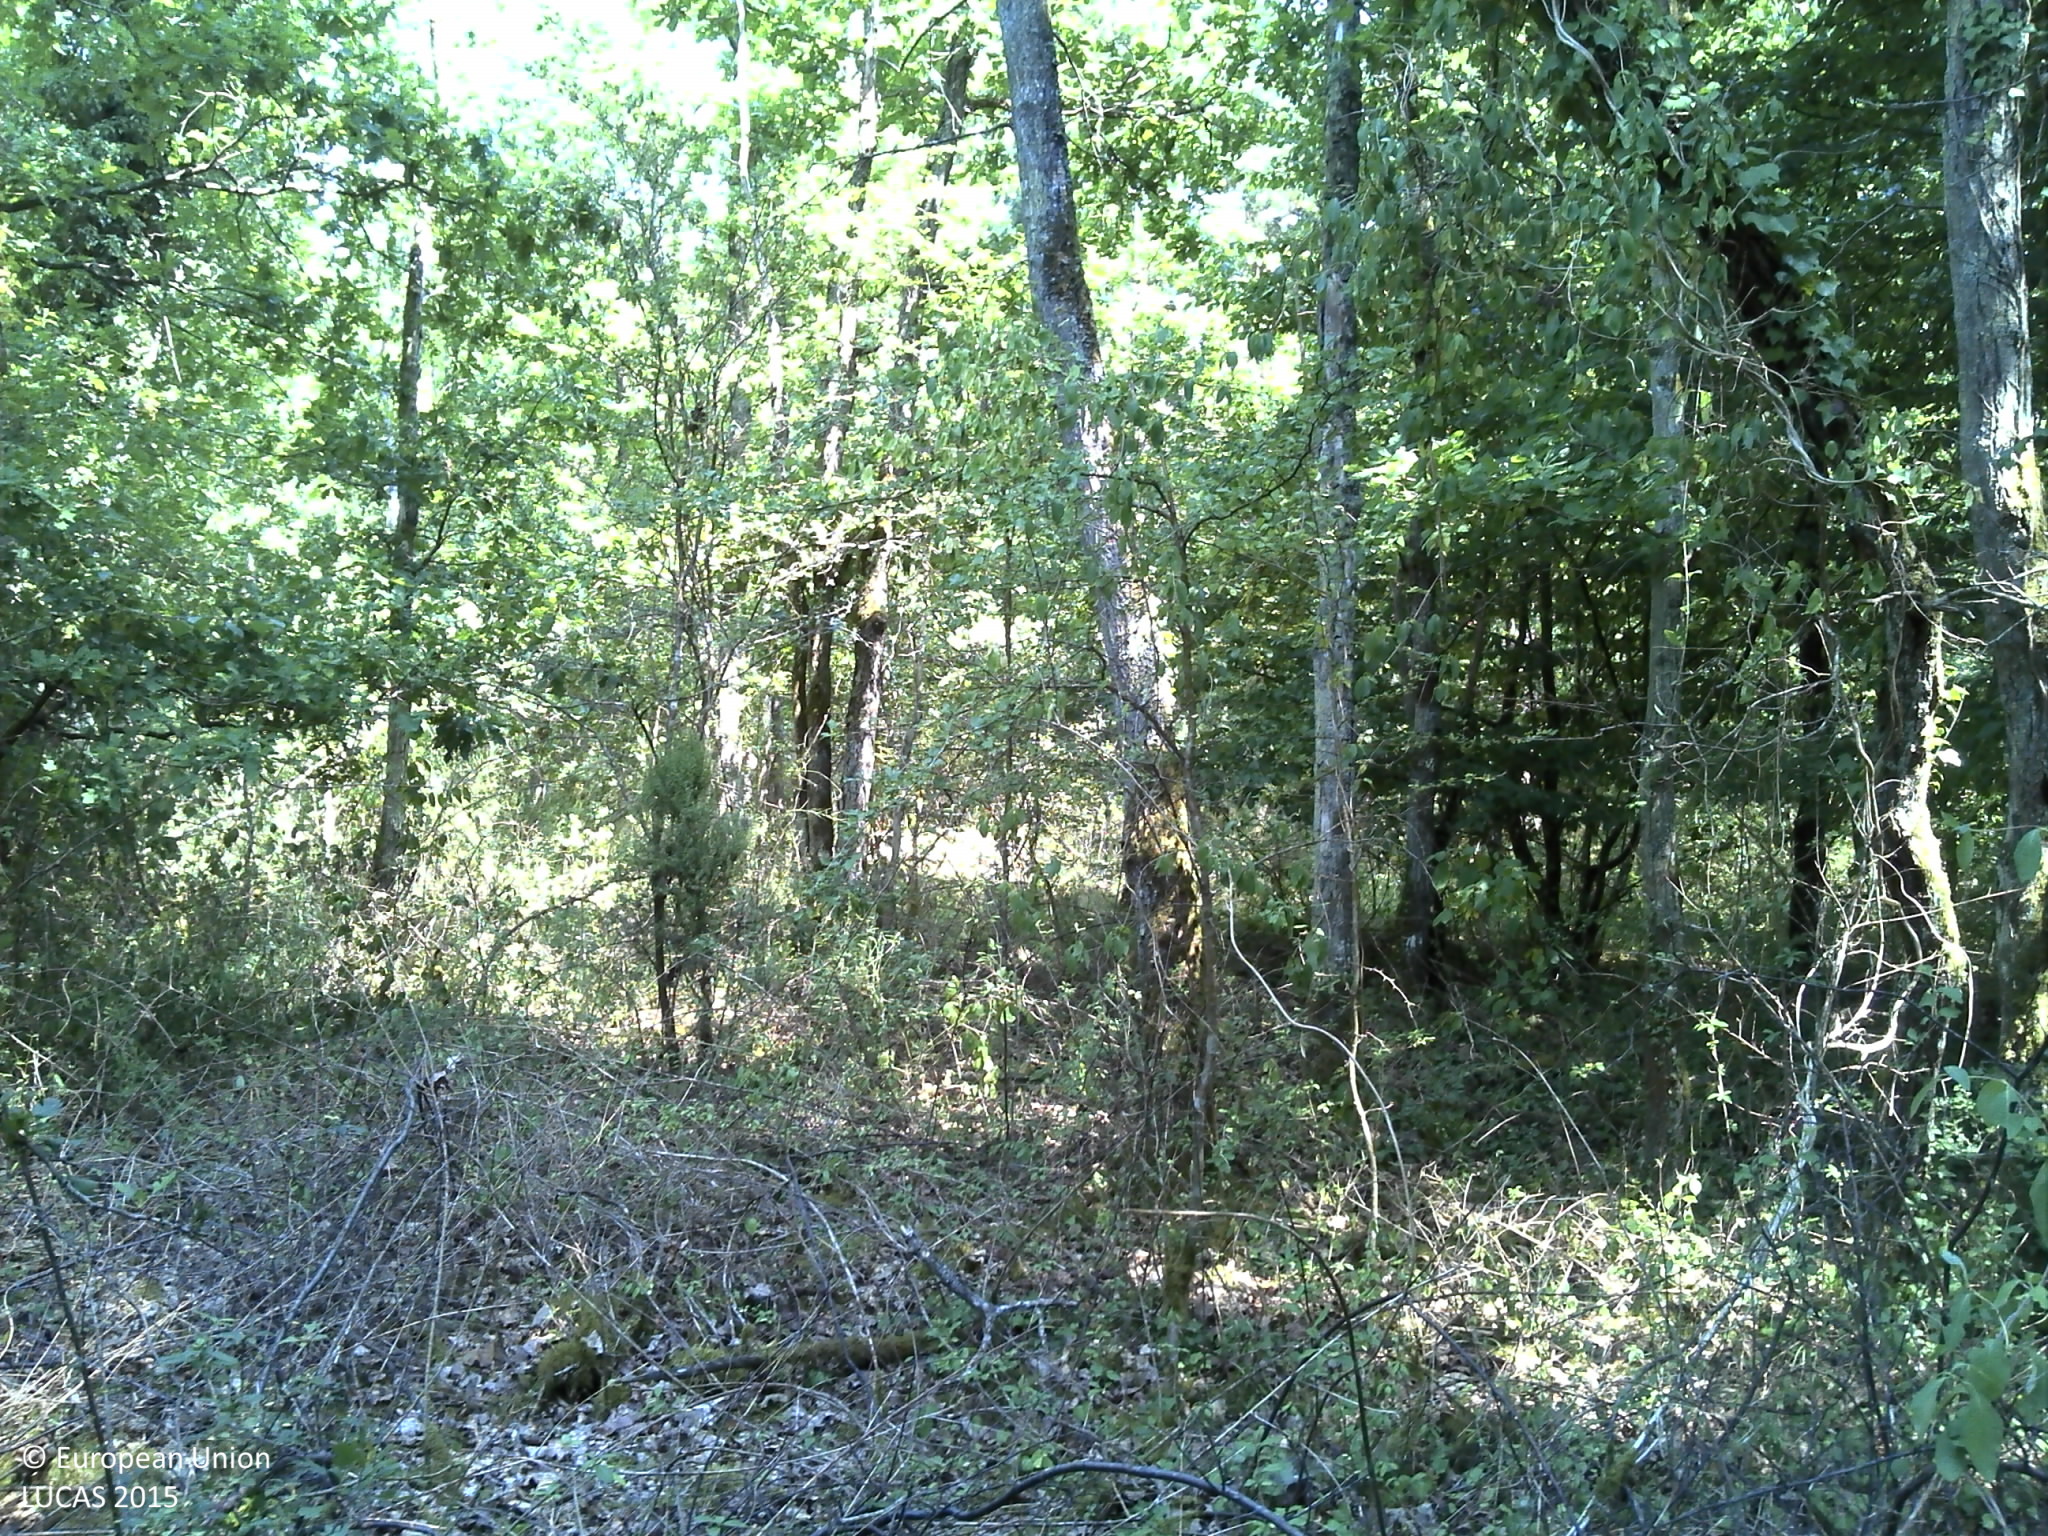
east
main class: Woodland
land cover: Broadleaved woodland
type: acidophilous oak and oak-birch forest
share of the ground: 50 - 75 %
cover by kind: broadleaved forest trees 90 %
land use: Forestry
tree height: > 5 m
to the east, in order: Broadleaved woodland; Tracks; Grass margins; Broadleaved woodland
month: July
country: FR
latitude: 48.4153
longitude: 2.4364
